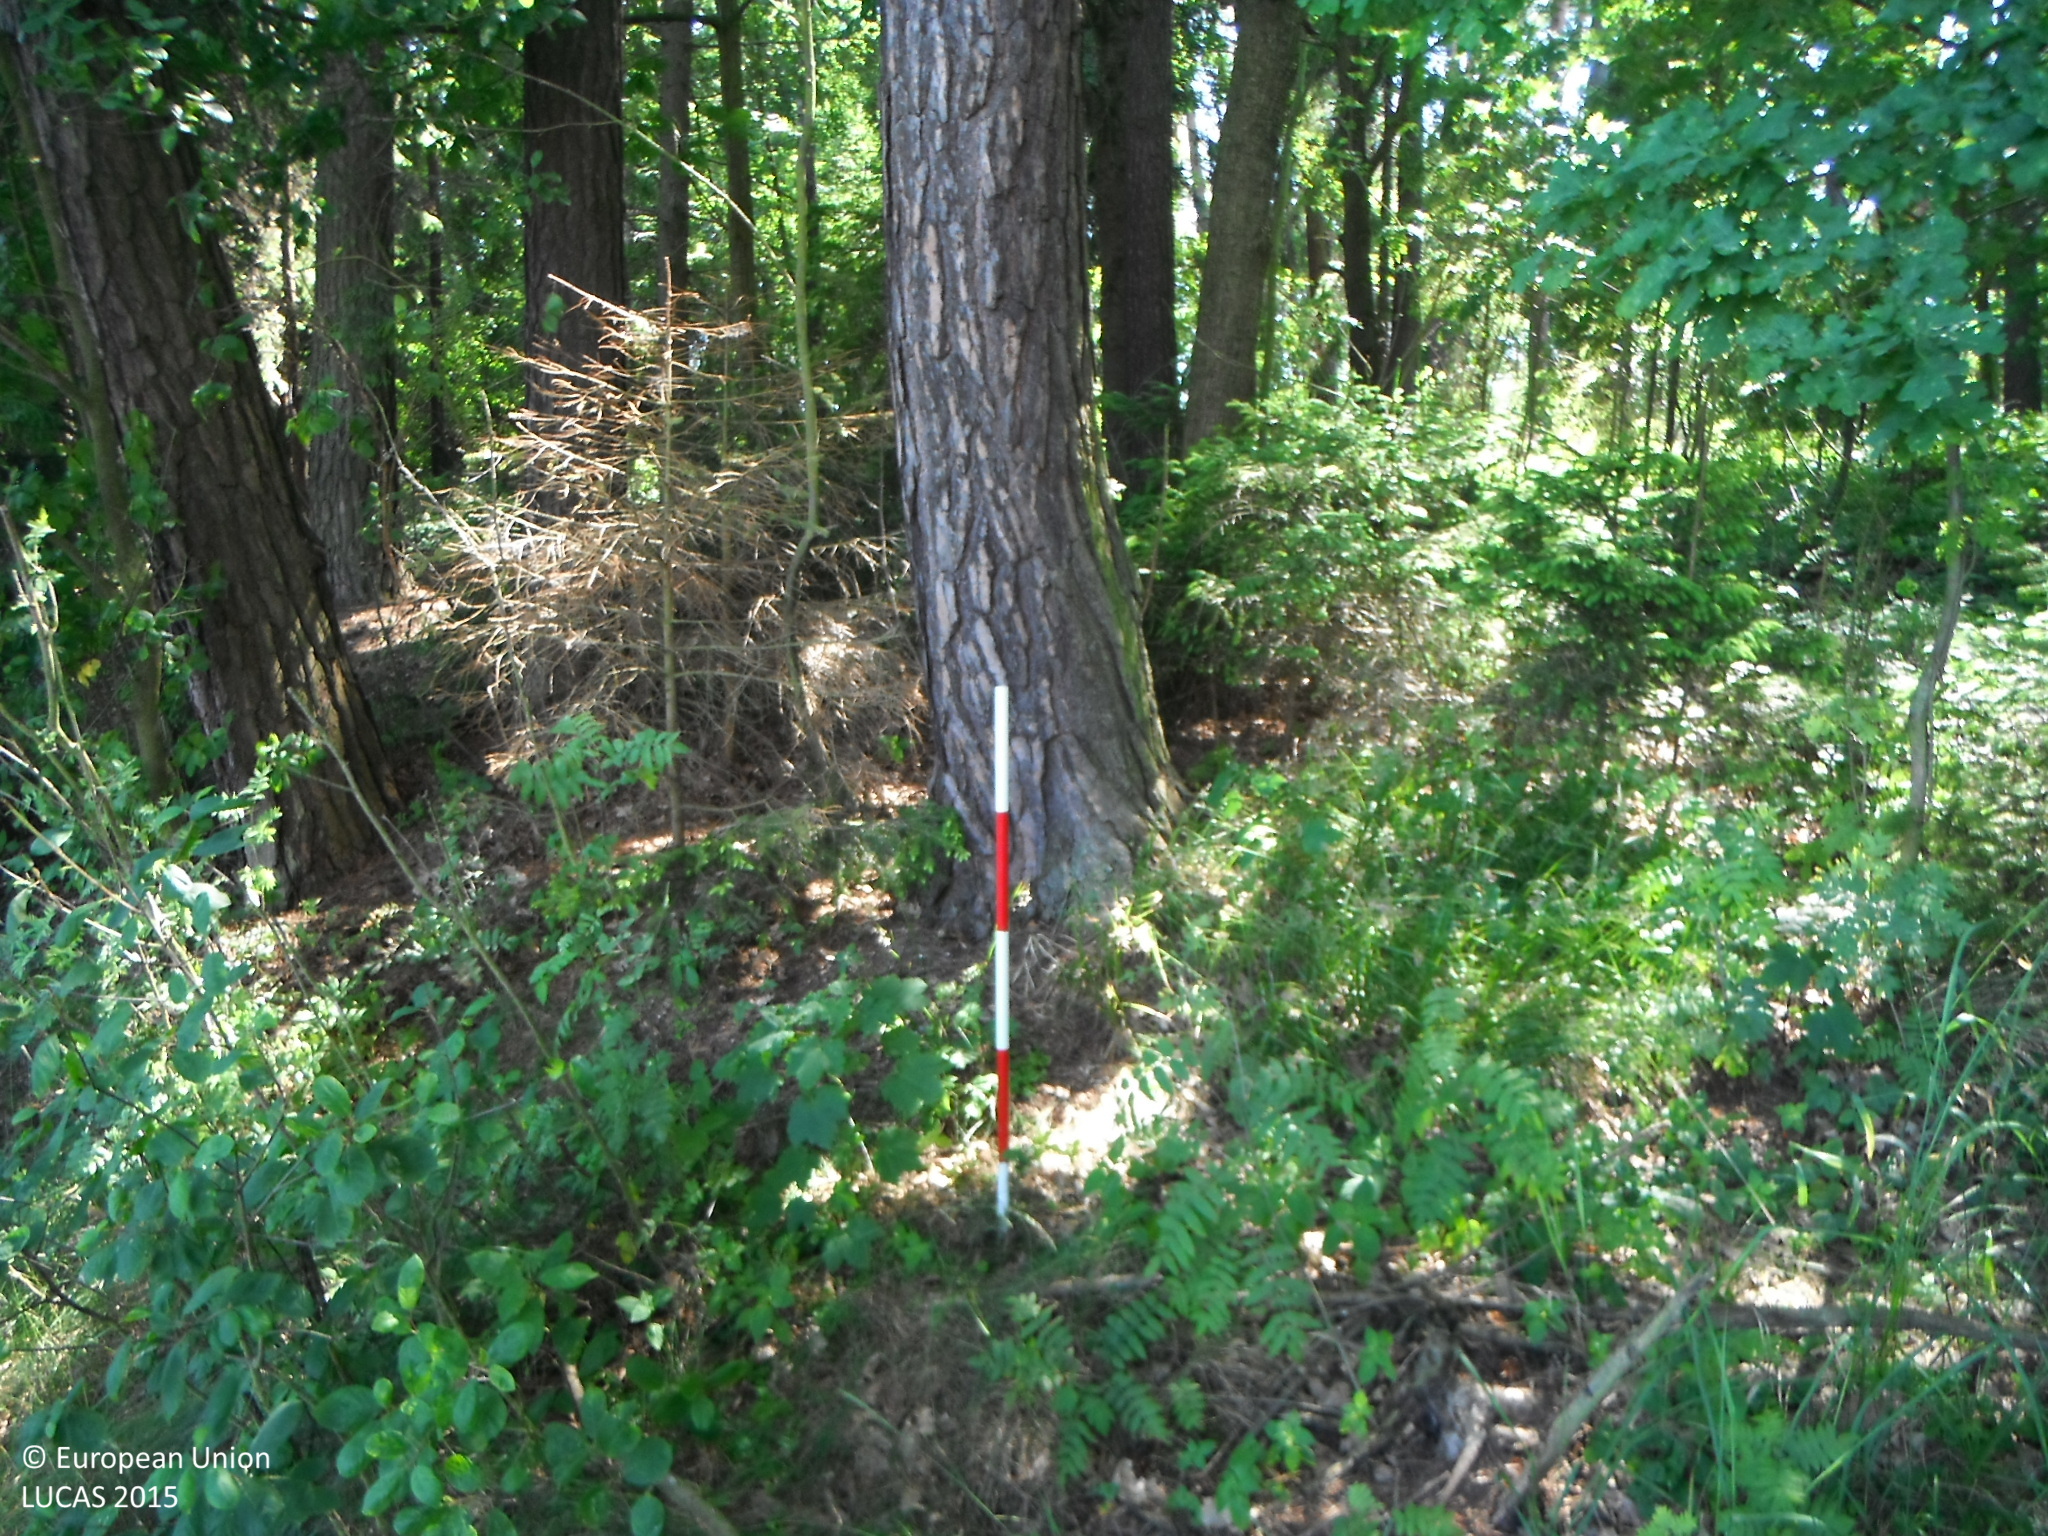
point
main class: Woodland
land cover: Other mixed woodland
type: hemiboreal forest and nemoral coniferous forest and mixed broadleaved-coniferous forest
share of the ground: > 75 %
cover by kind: broadleaved forest trees 55 %, coniferous forest trees 40 %, herbaceous plants 5 %
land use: Forestry
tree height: > 5 m
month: July
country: SK
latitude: 48.9353
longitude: 20.6997
